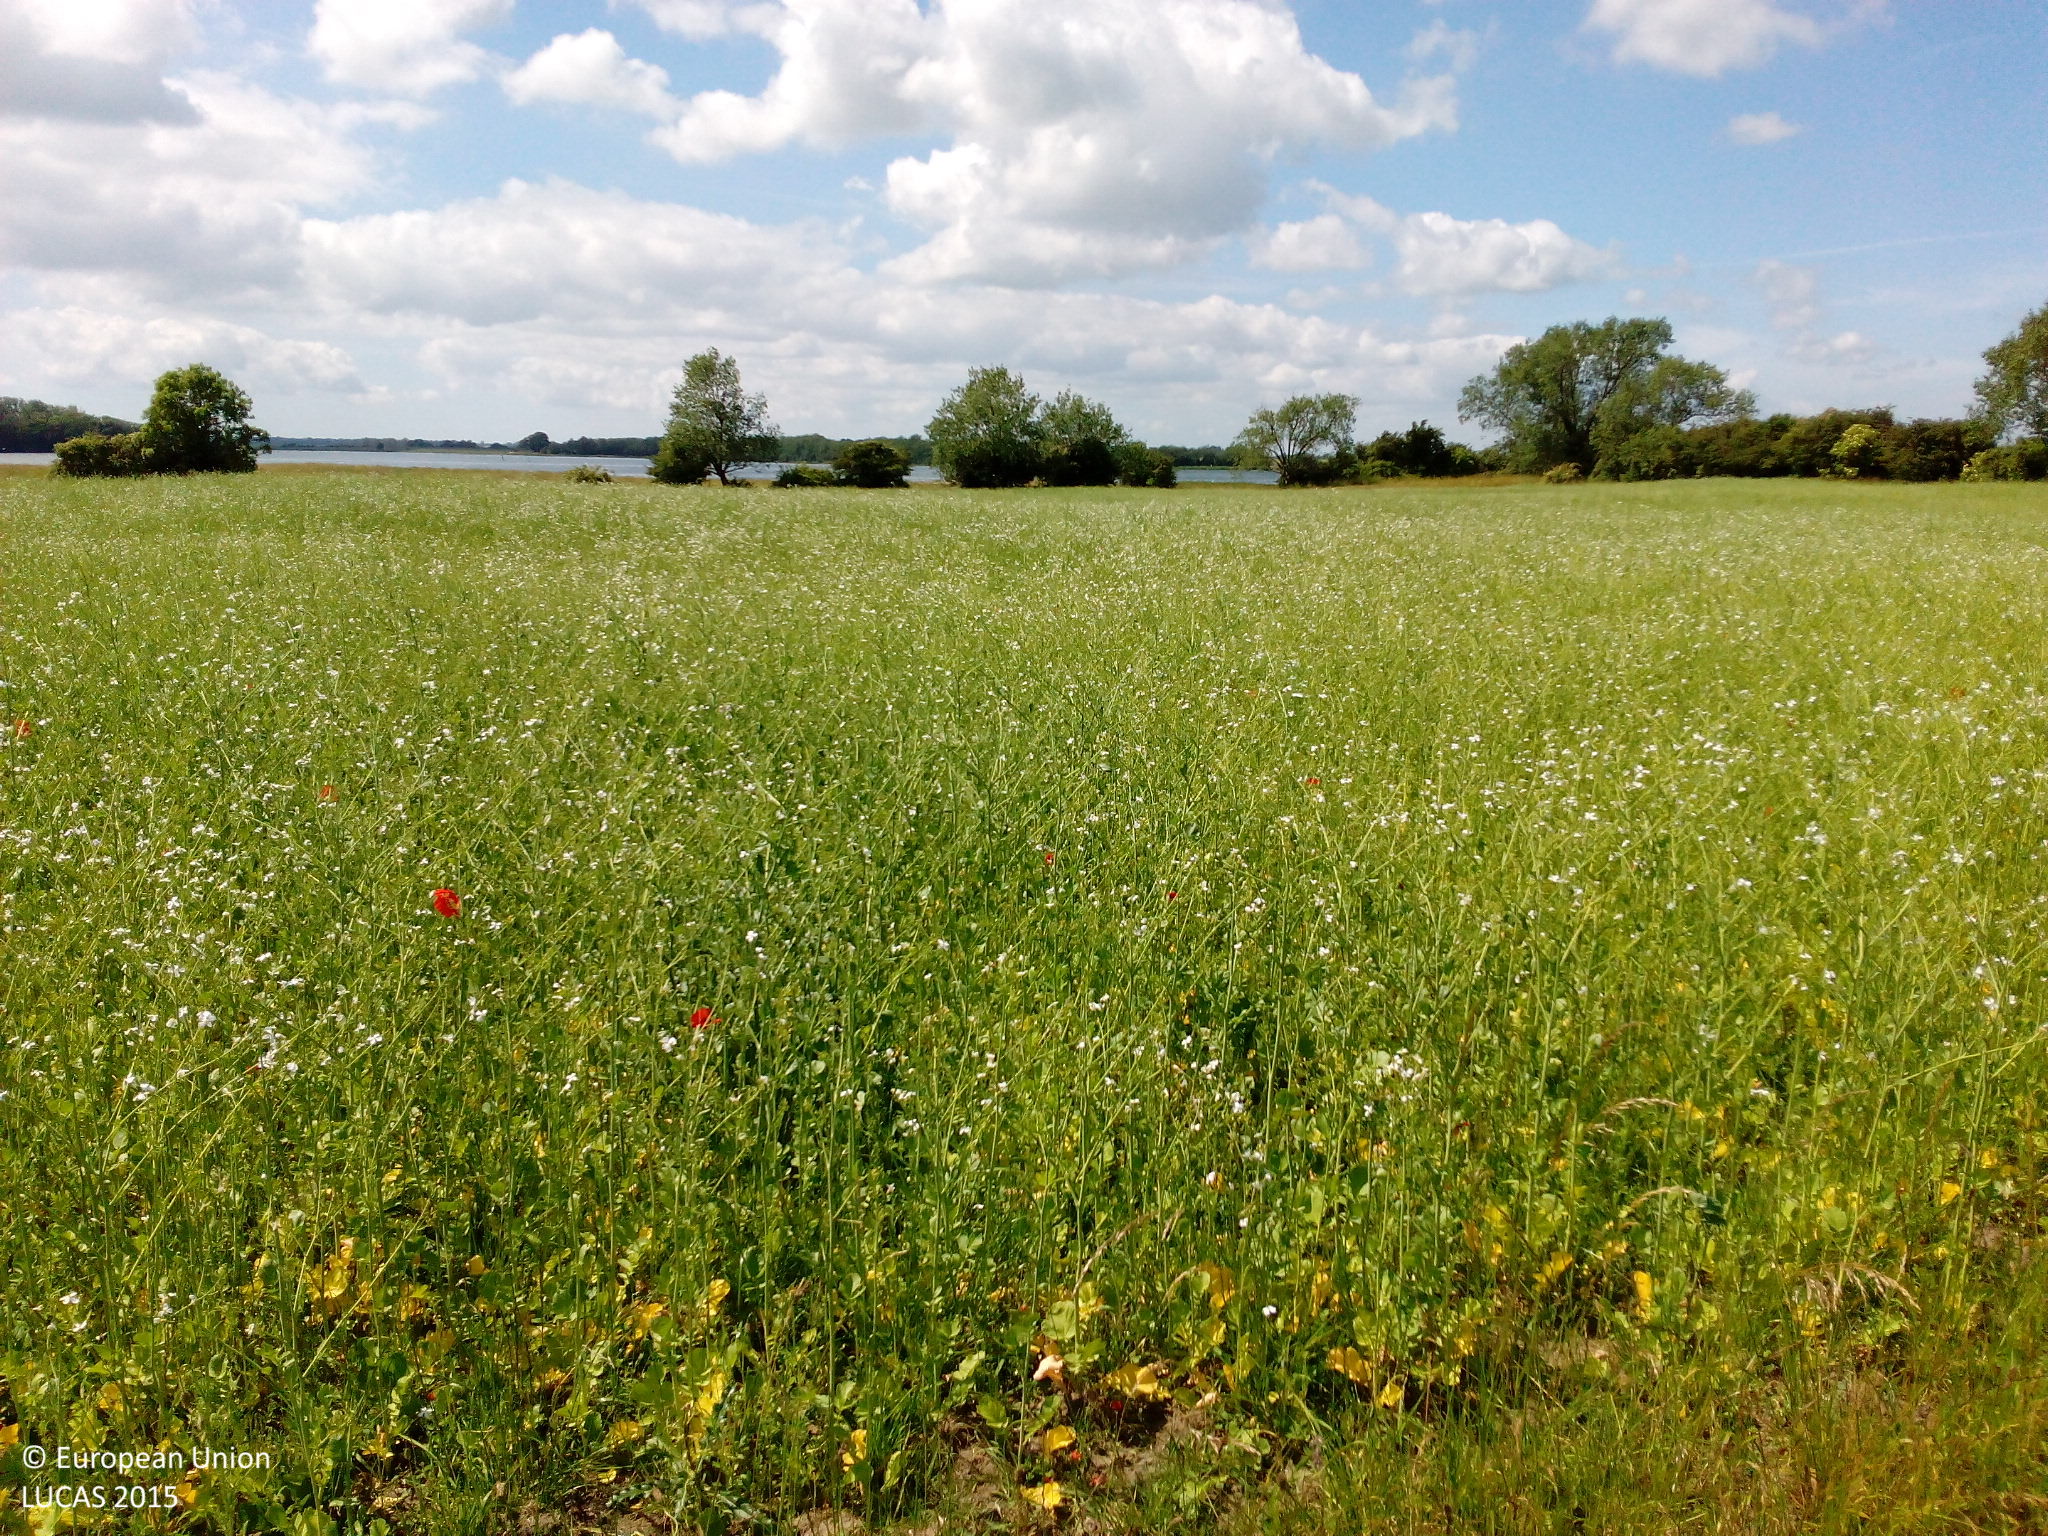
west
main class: Cropland
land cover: Dry pulses
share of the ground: > 75 %
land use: Agriculture (excluding fallow land and kitchen gardens)
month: June
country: DK
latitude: 54.7357
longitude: 11.8781
